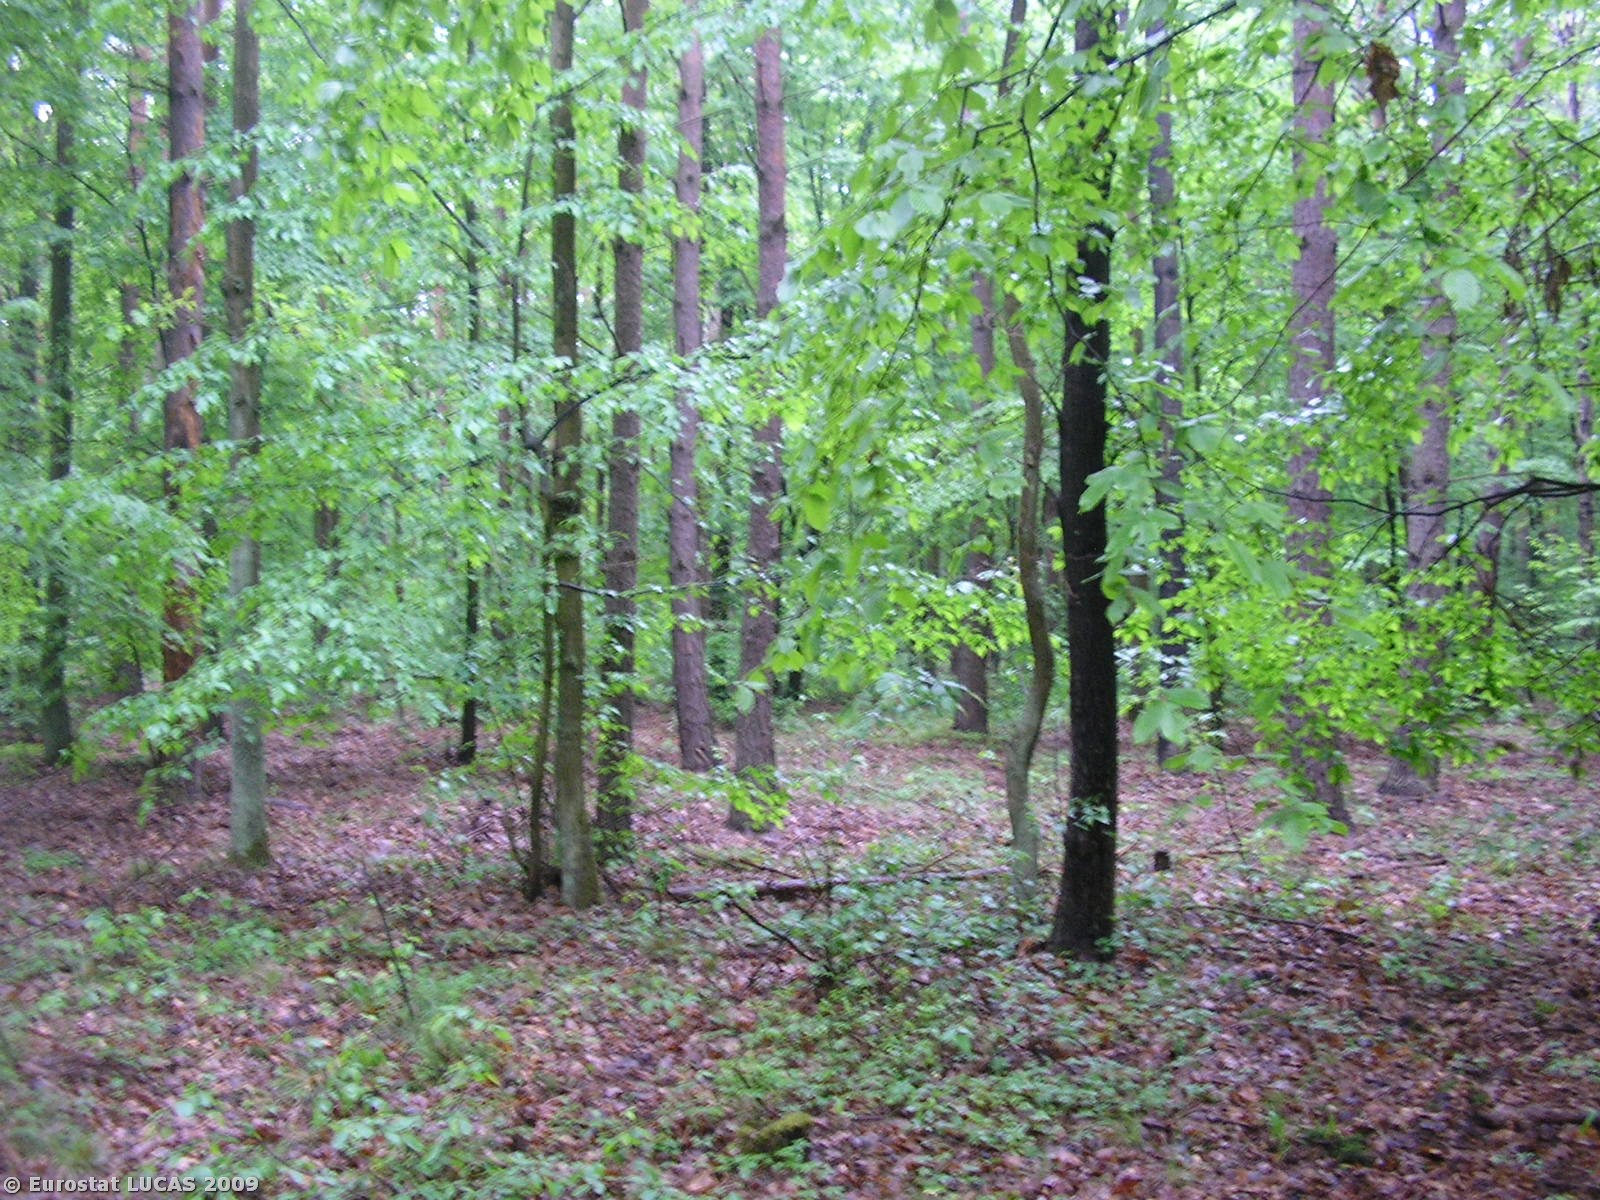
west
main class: Woodland
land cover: Broadleaved woodland
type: mesophytic deciduous forest
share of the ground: > 75 %
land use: Forestry
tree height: > 5 m
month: May
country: PL
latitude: 51.5936
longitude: 19.9785
